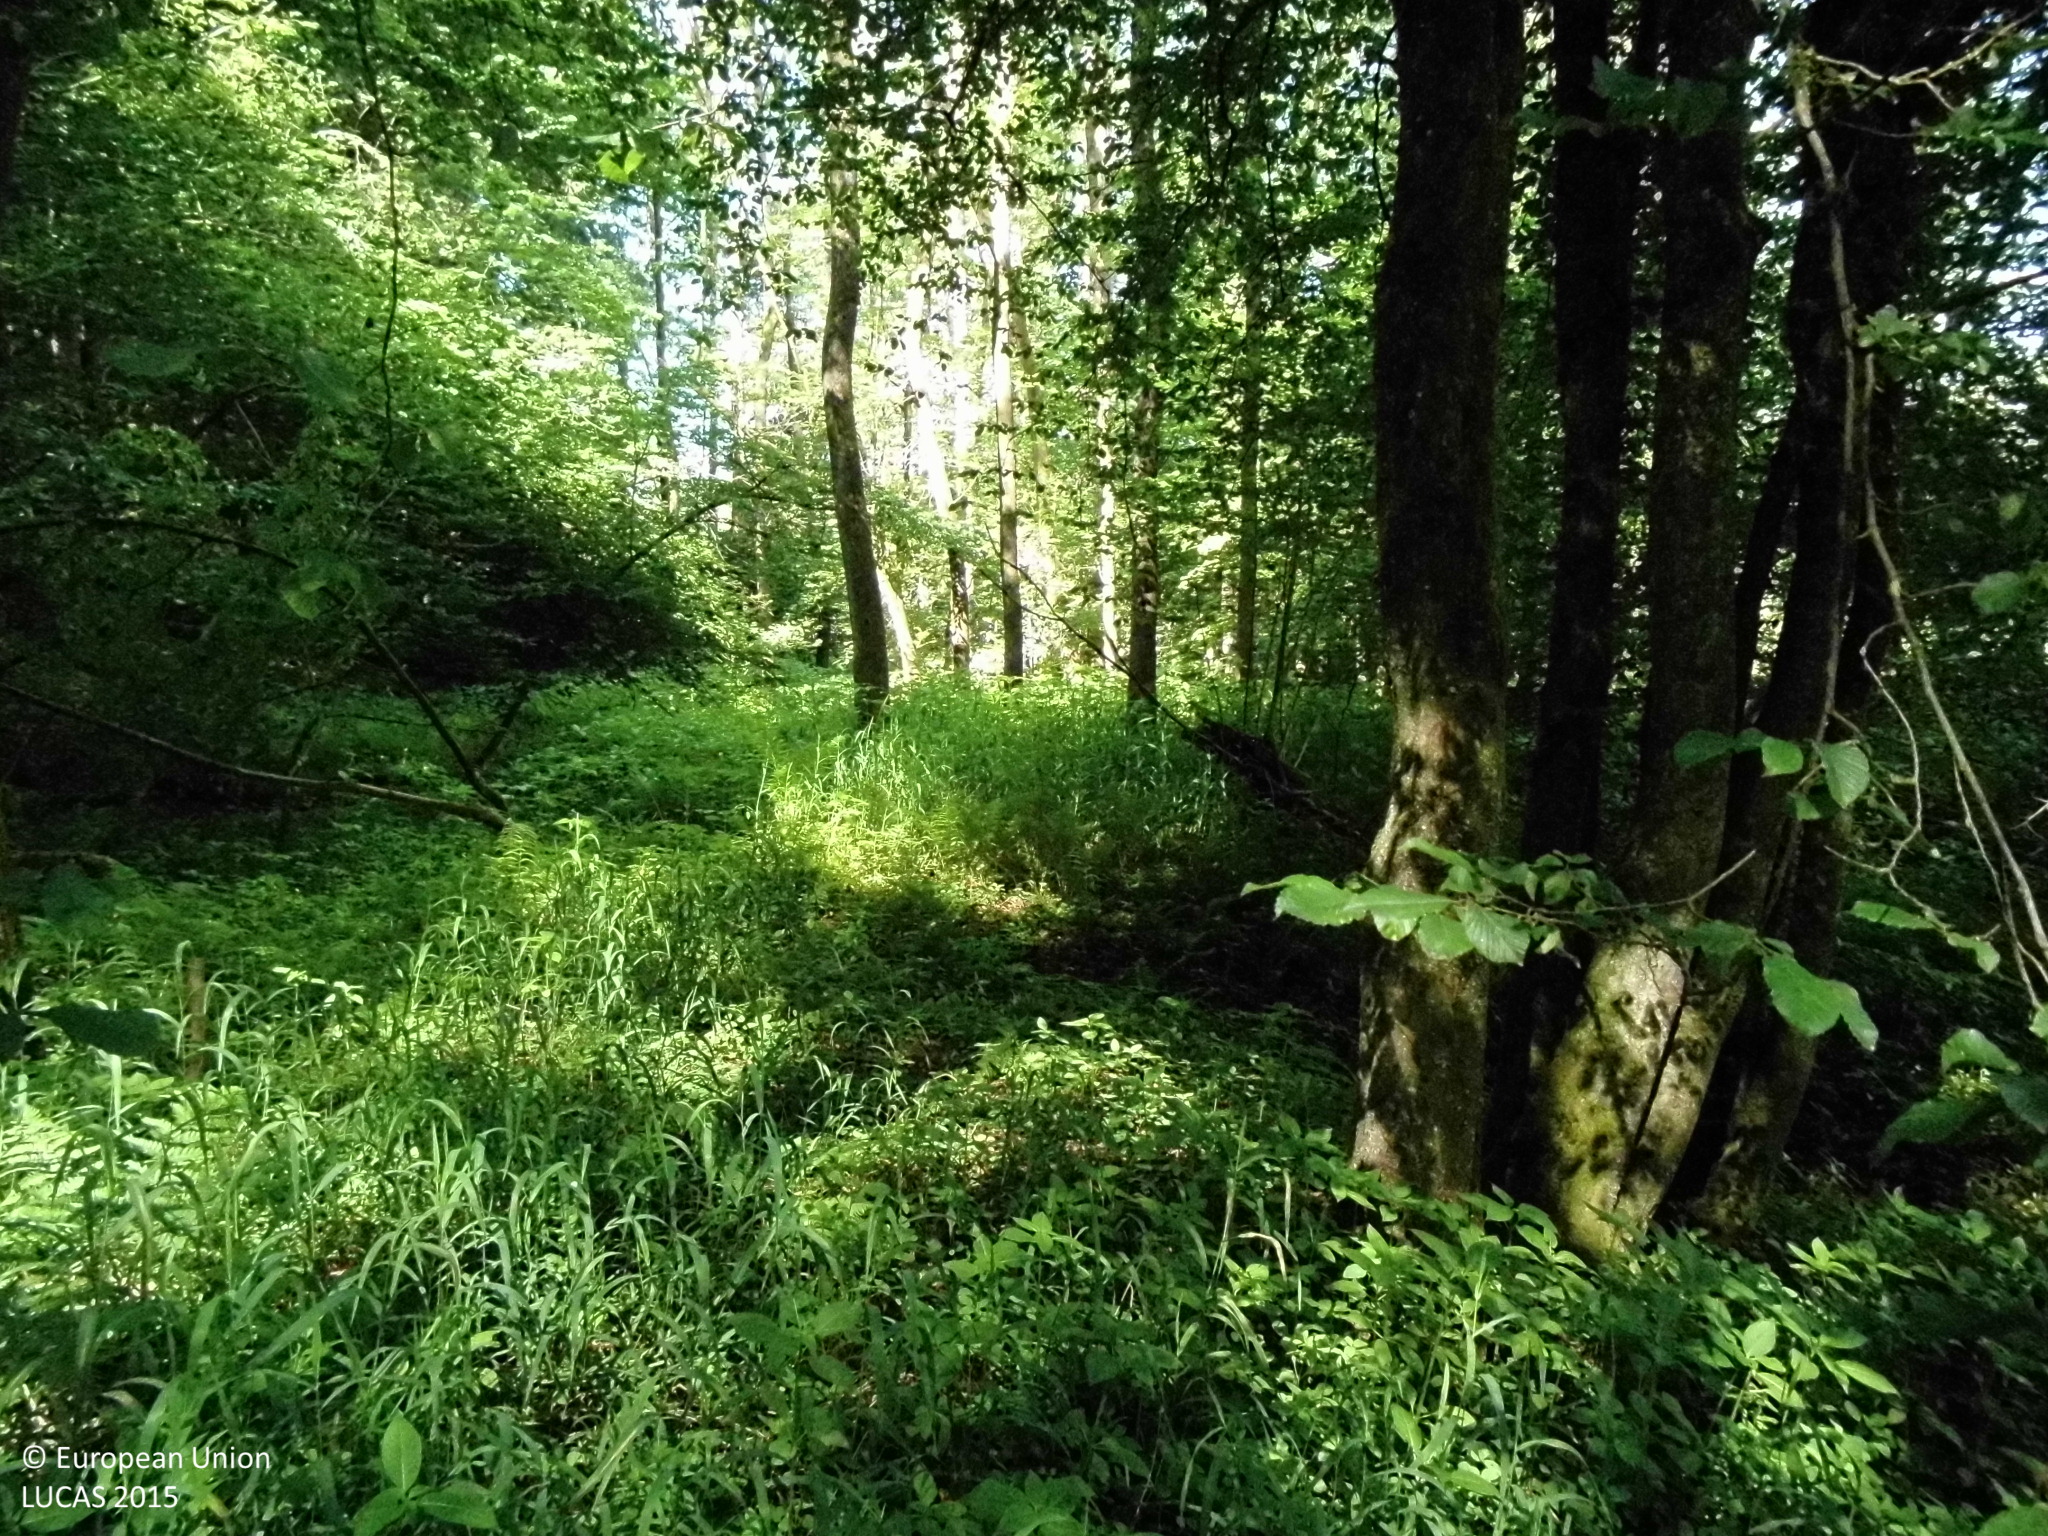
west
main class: Woodland
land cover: Broadleaved woodland
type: mesophytic deciduous forest
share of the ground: > 75 %
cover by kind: broadleaved forest trees 85 %, herbaceous plants 15 %
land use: Forestry
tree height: > 5 m
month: June
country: DE
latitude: 50.9108
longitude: 7.4260
